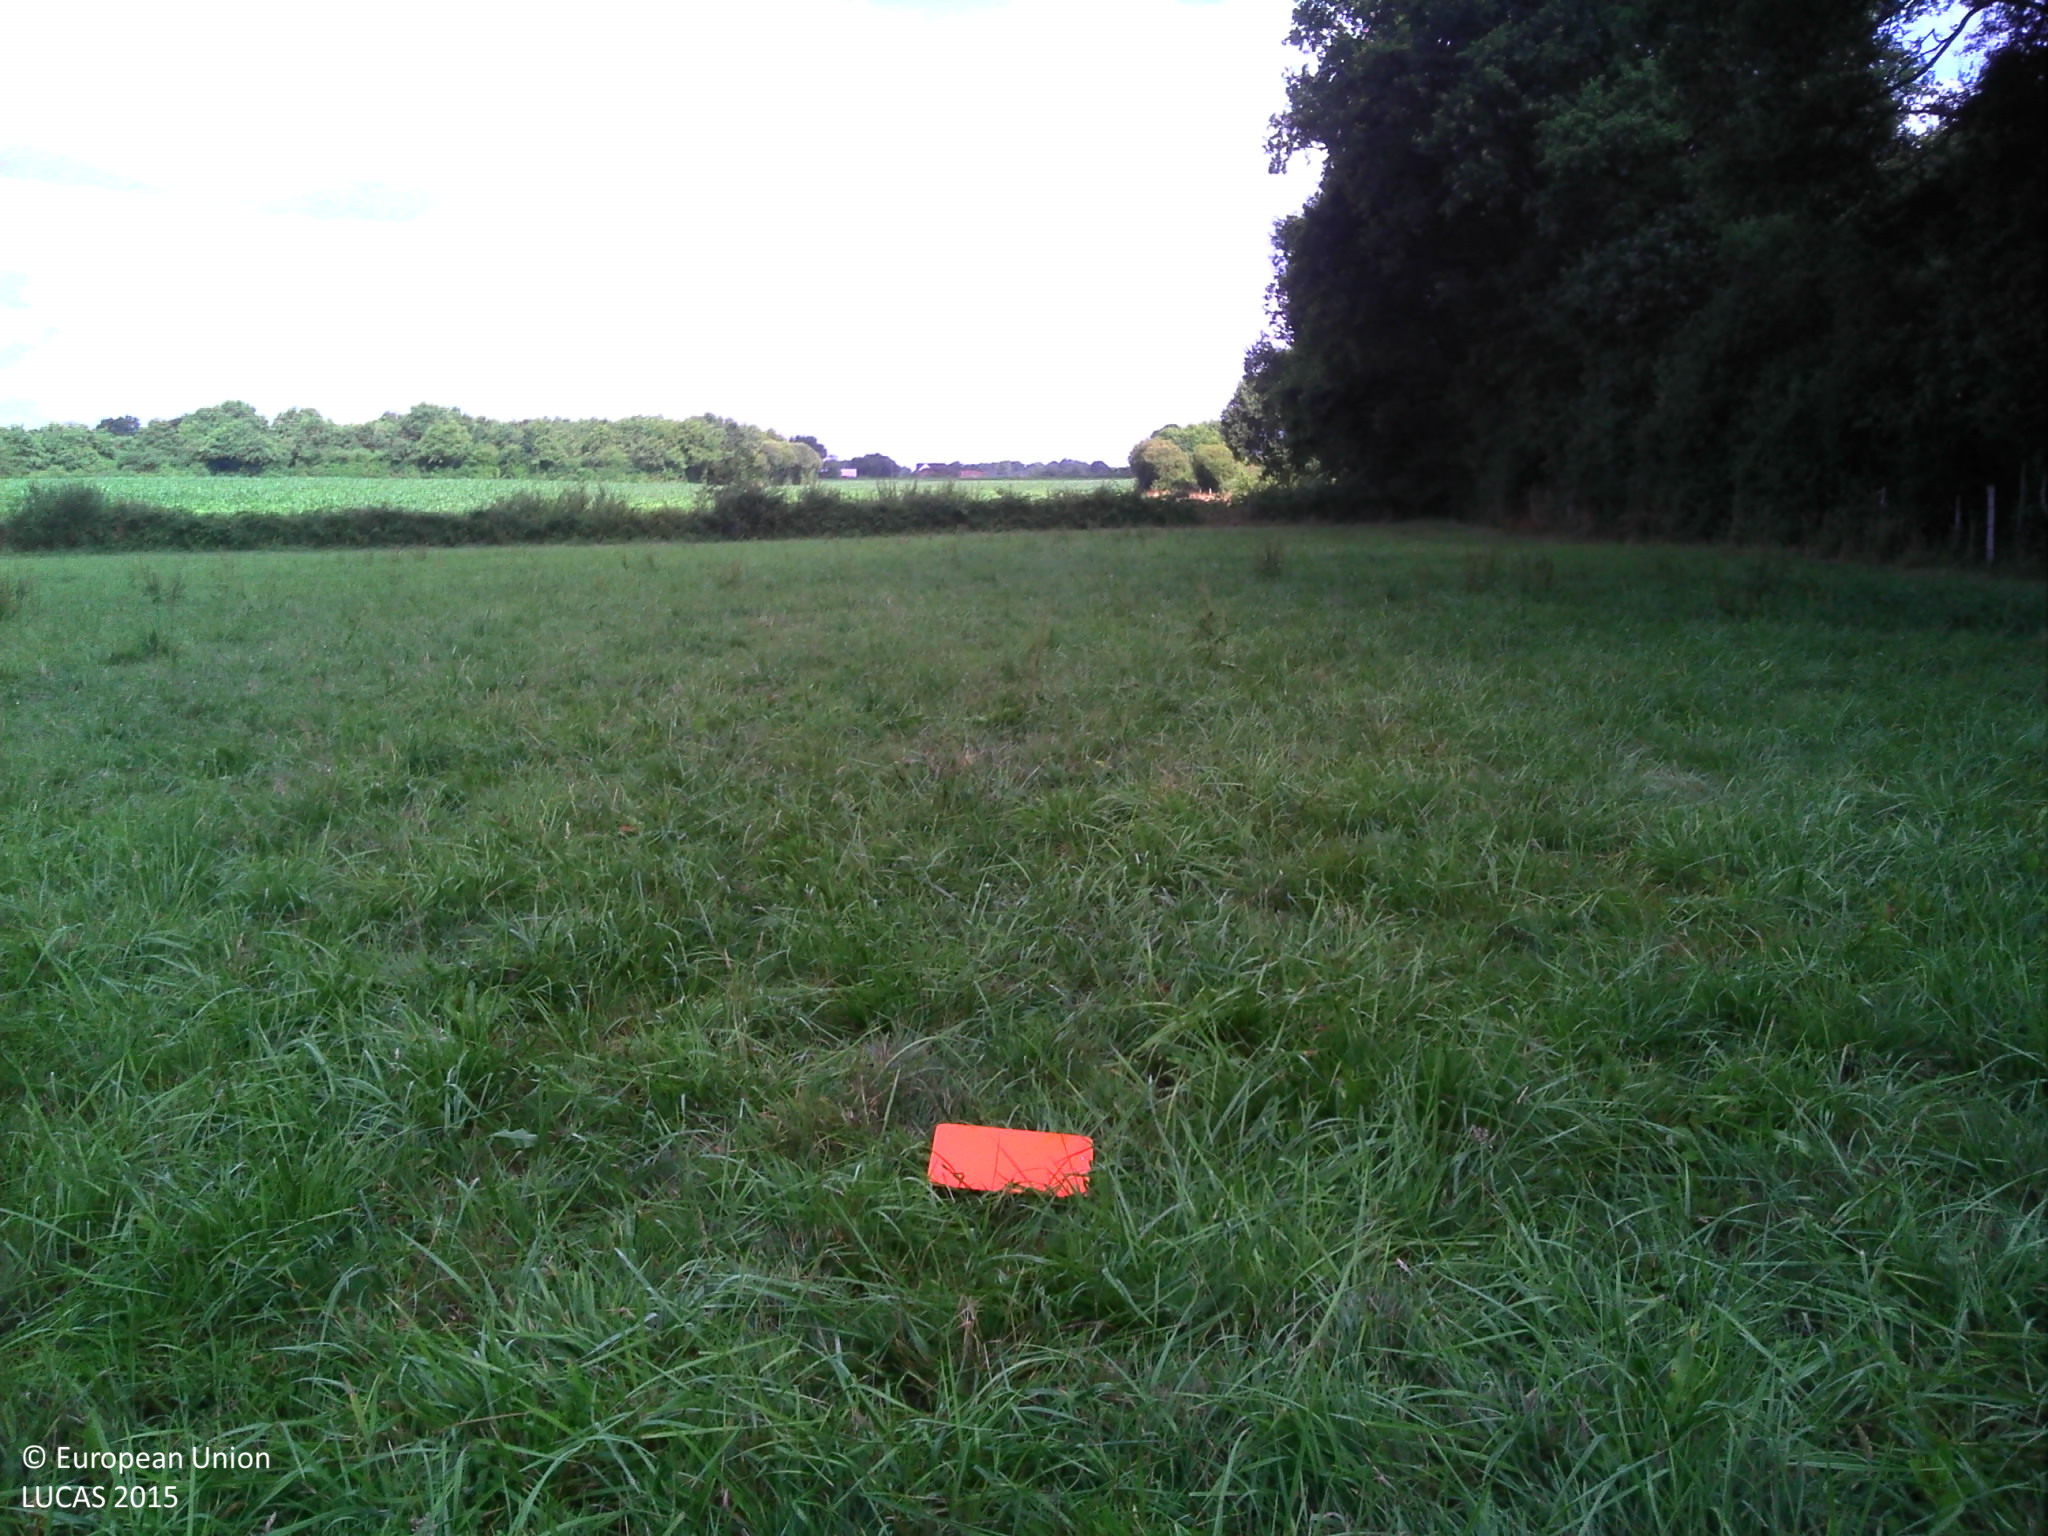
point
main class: Cropland
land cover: Temporary grasslands
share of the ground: > 75 %
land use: Agriculture (excluding fallow land and kitchen gardens)
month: July
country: FR
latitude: 47.3748
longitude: -1.5786
